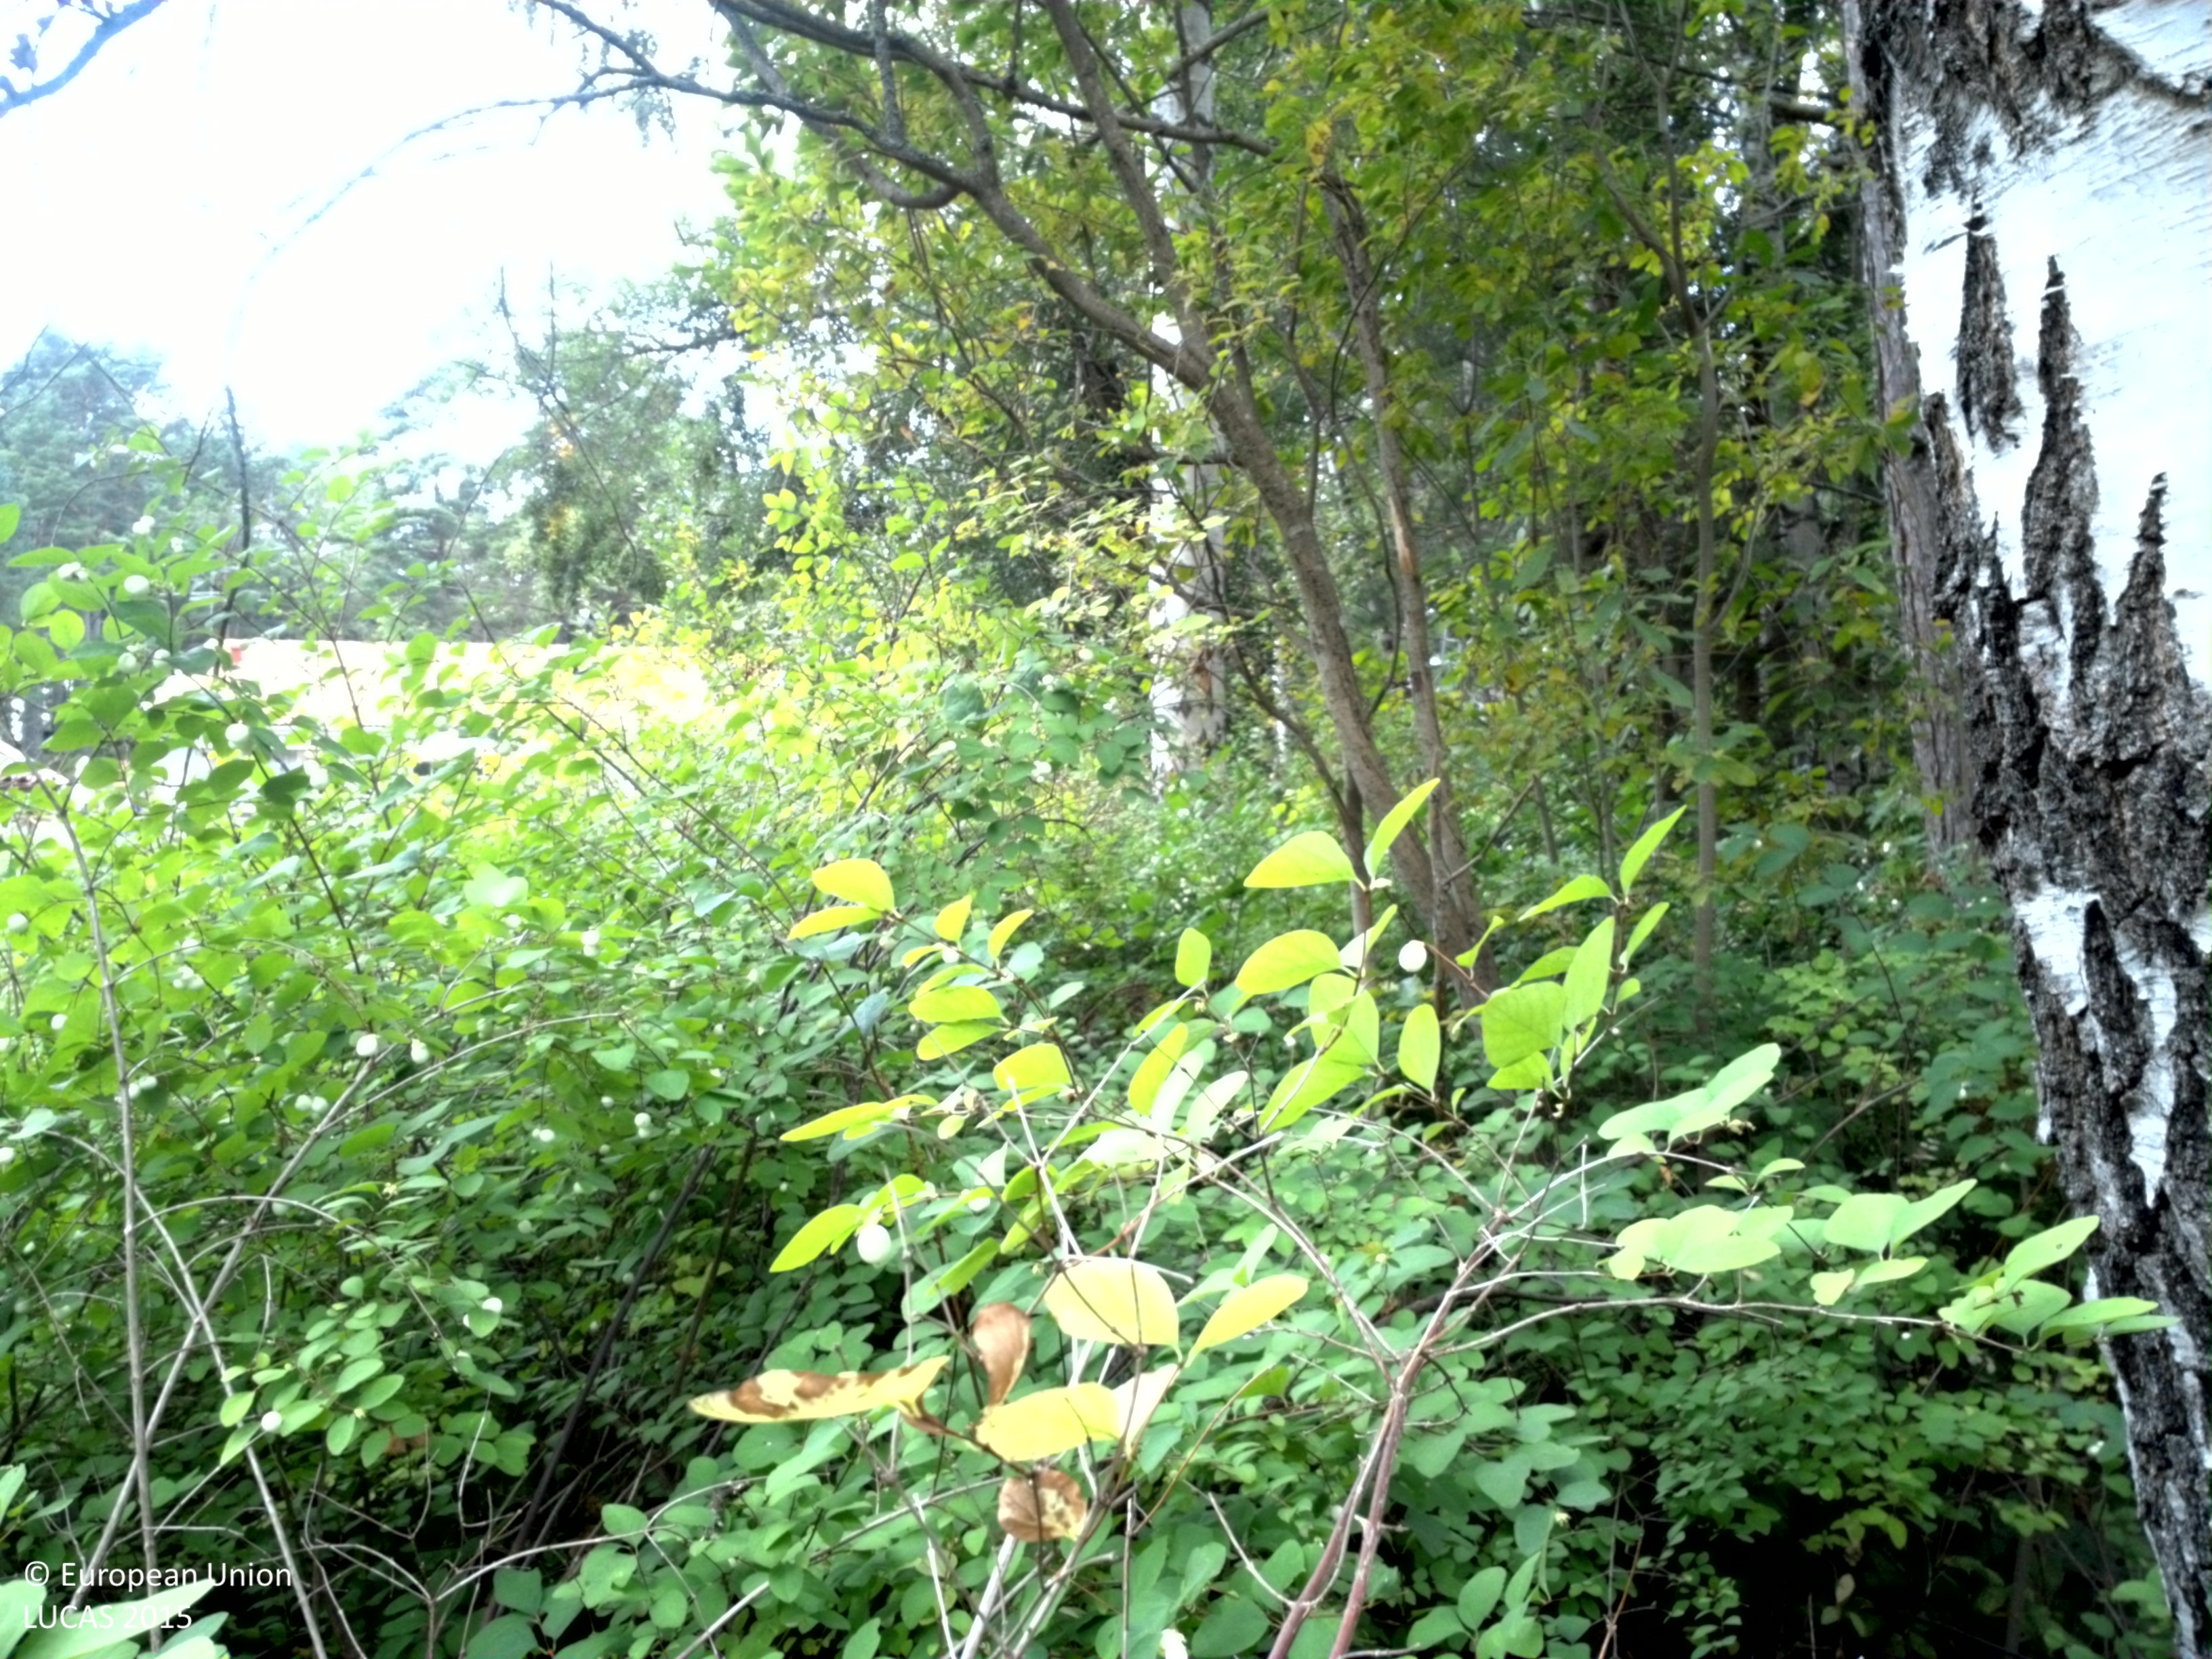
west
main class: Woodland
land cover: Broadleaved woodland
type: boreal forest
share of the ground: 50 - 75 %
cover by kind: broadleaved forest trees 65 %, shrubs 20 %, coniferous forest trees 10 %, herbaceous plants 5 %
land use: Amenities, museums, leisure
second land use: Residential
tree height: > 5 m
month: September
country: SE
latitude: 59.2376
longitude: 18.4674
